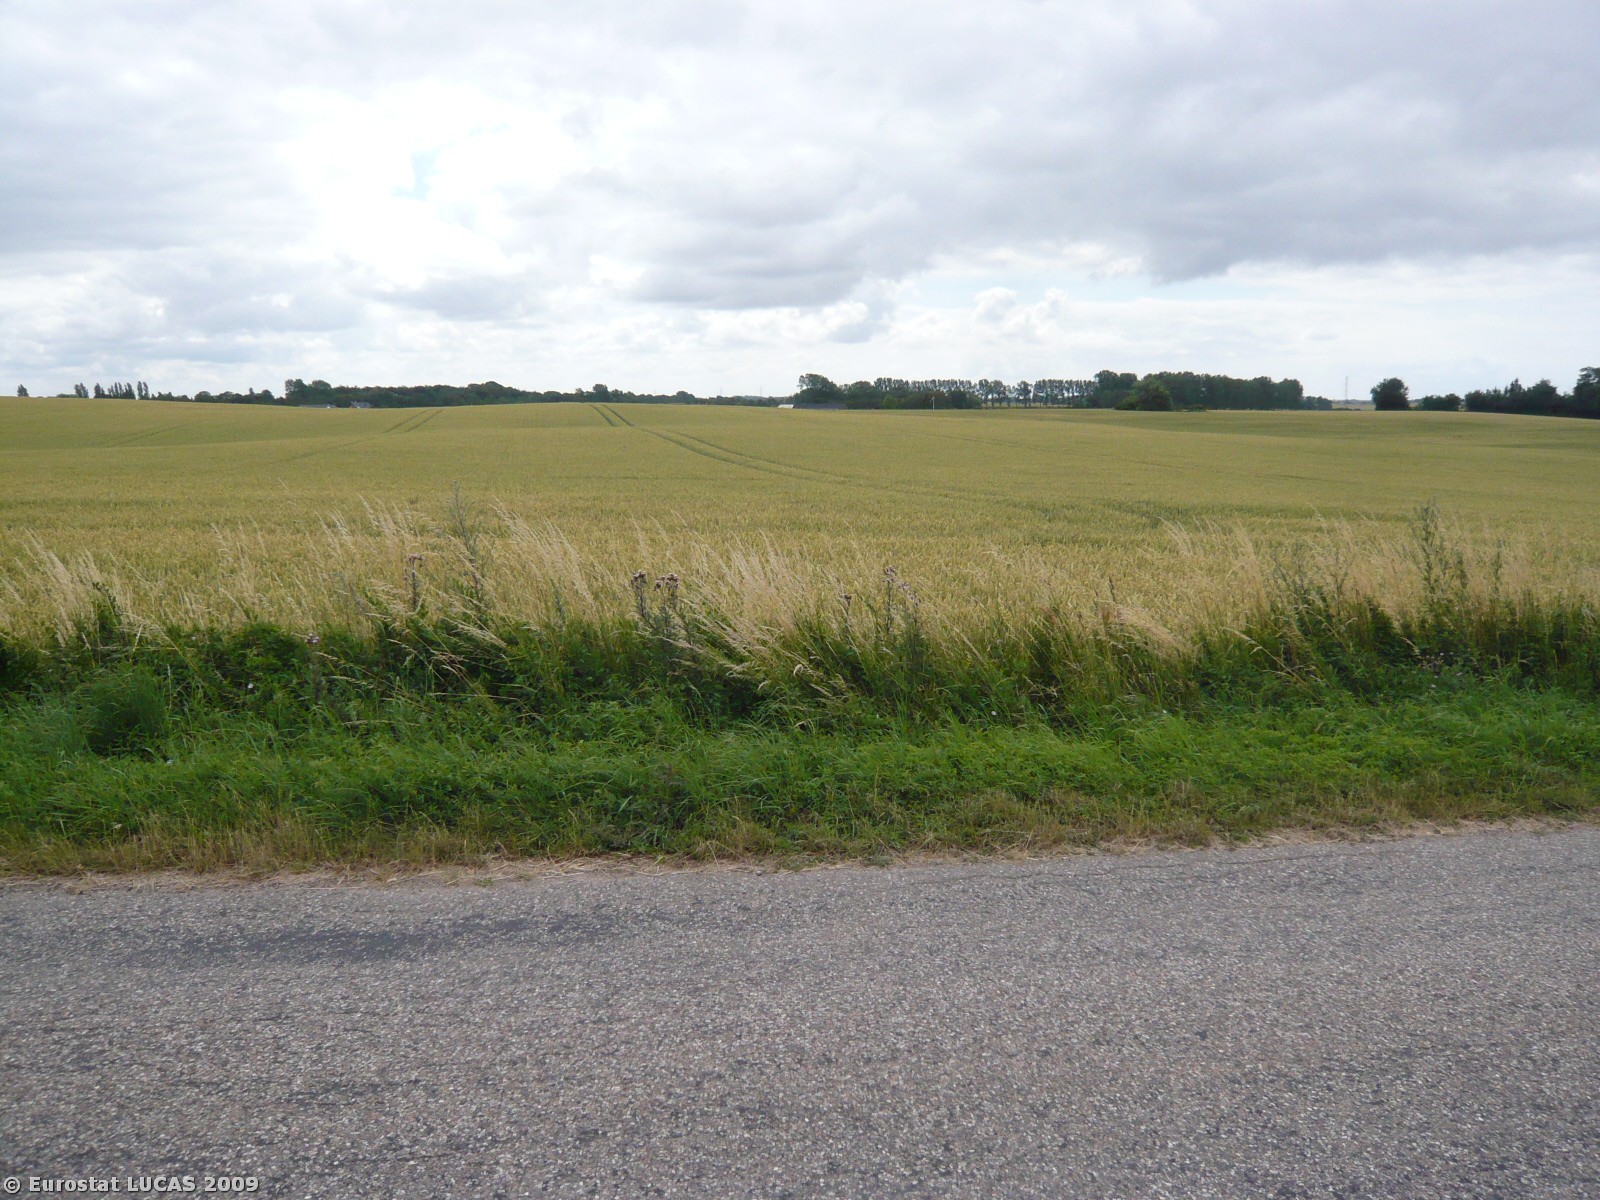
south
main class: Cropland
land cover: Barley
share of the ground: > 75 %
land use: Agriculture (excluding fallow land and kitchen gardens)
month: July
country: DK
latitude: 55.6067
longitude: 11.2211
